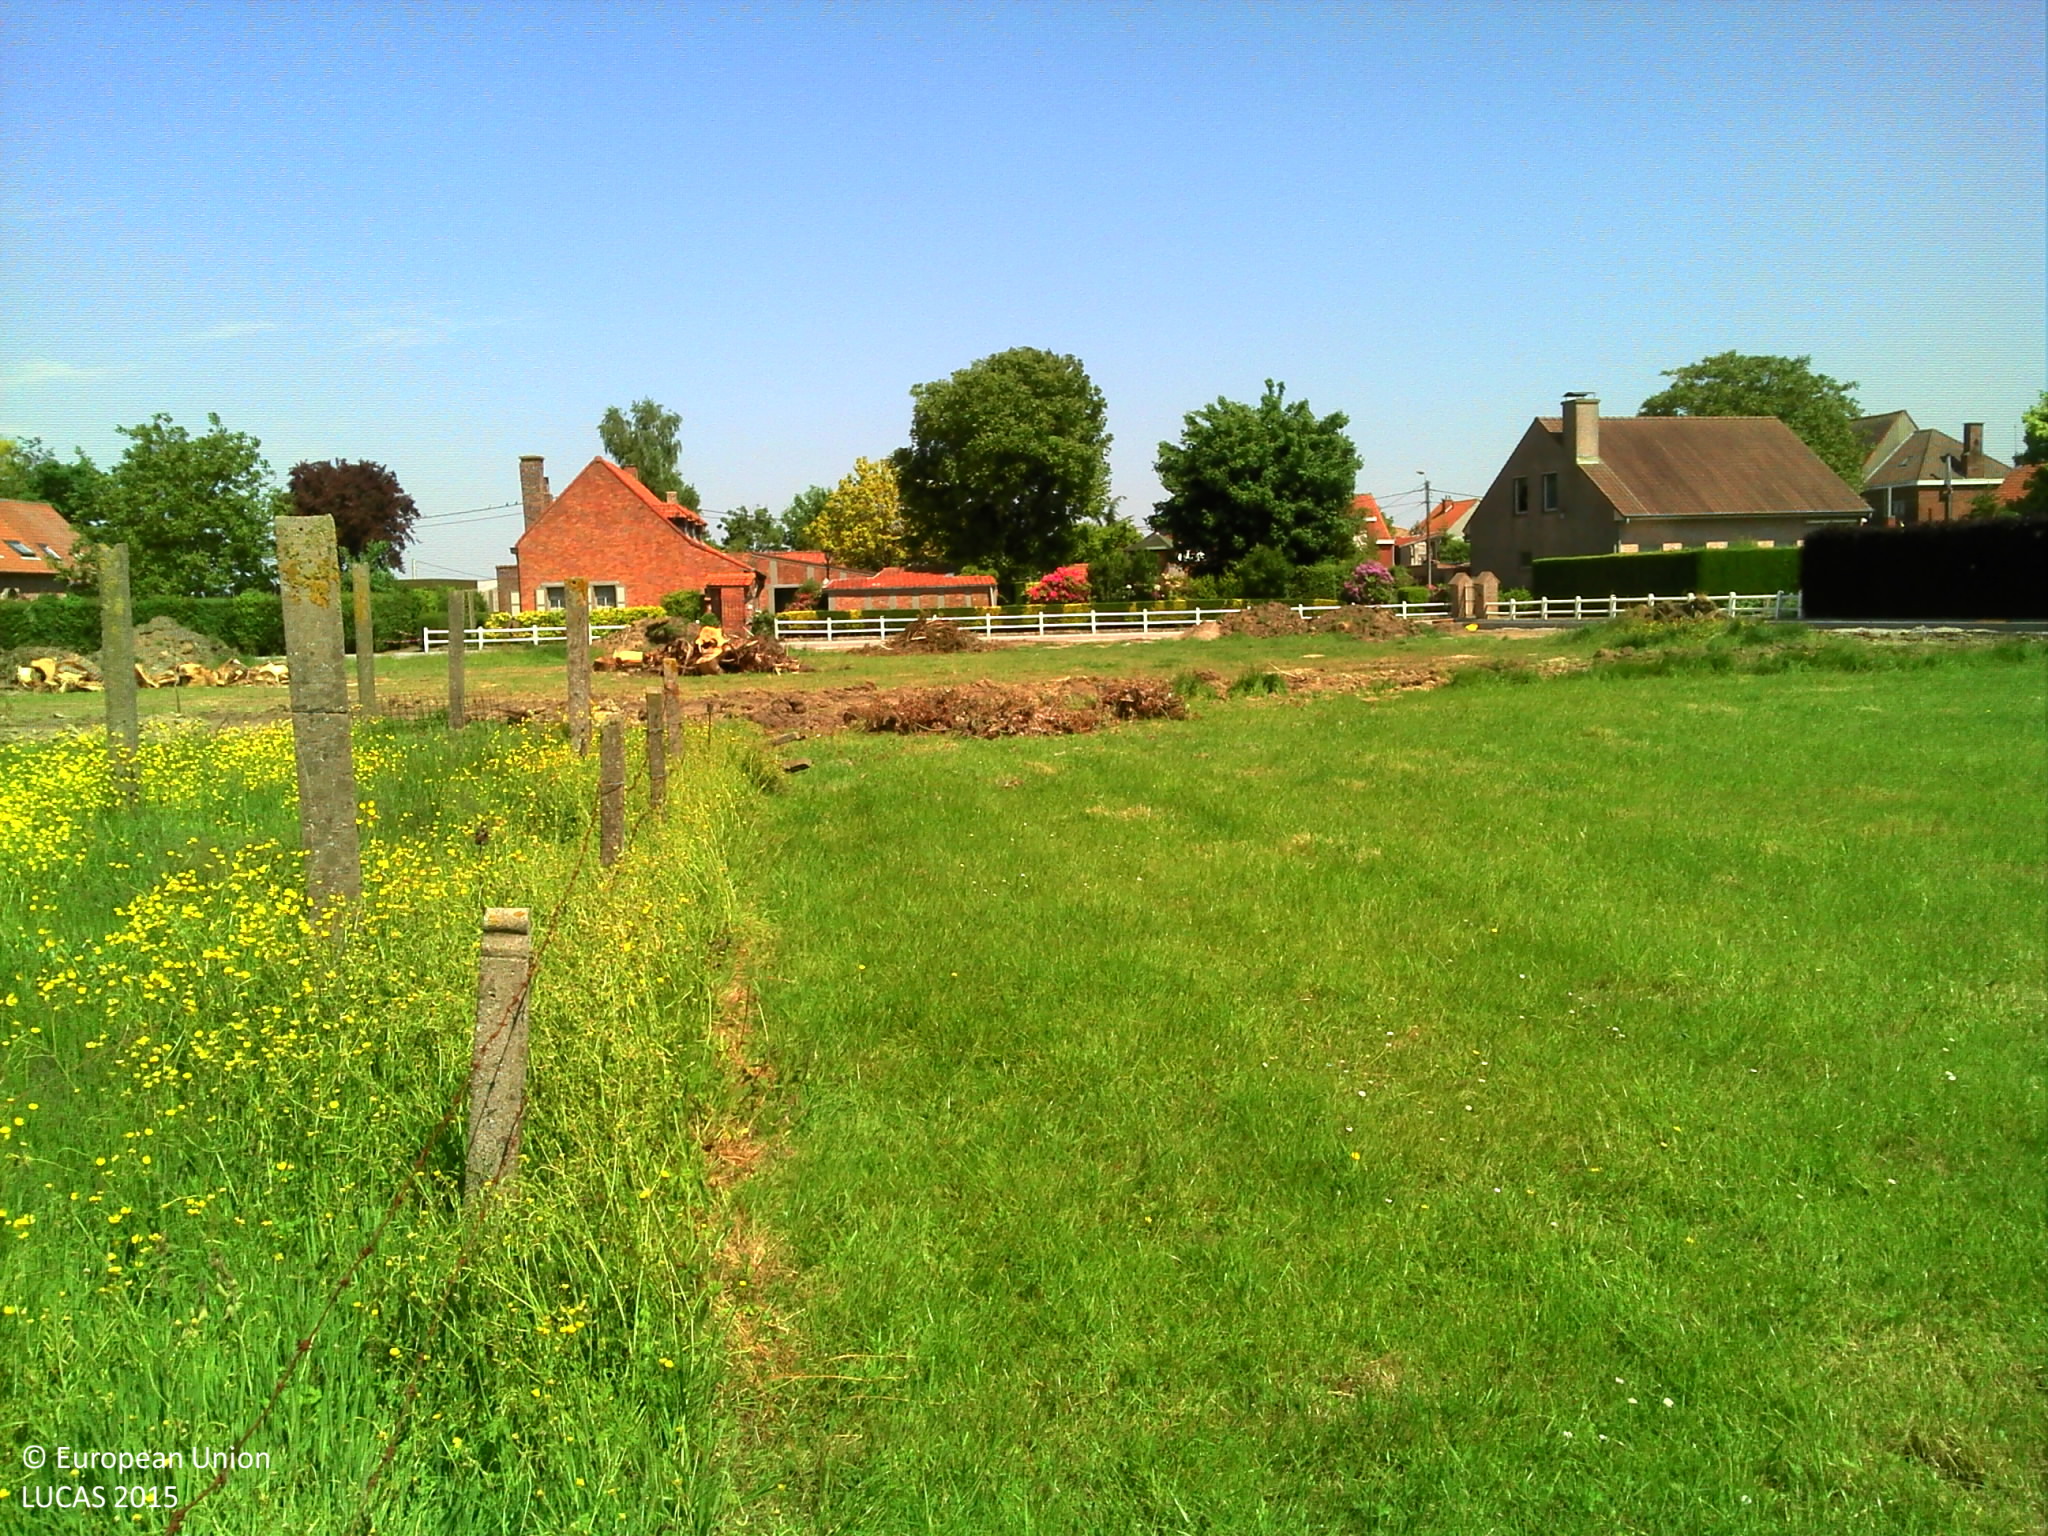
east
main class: Grassland
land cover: Grassland without tree/shrub cover
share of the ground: > 75 %
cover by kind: herbaceous plants 100 %
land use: Semi-natural and natural areas not in use
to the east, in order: Fences; Grassland without tree/shrub cover; Ditches and canals; Other bare soil; Grassland without tree/shrub cover; Artificial constructions in urban areas
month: June
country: BE
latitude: 50.8186
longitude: 3.0206
